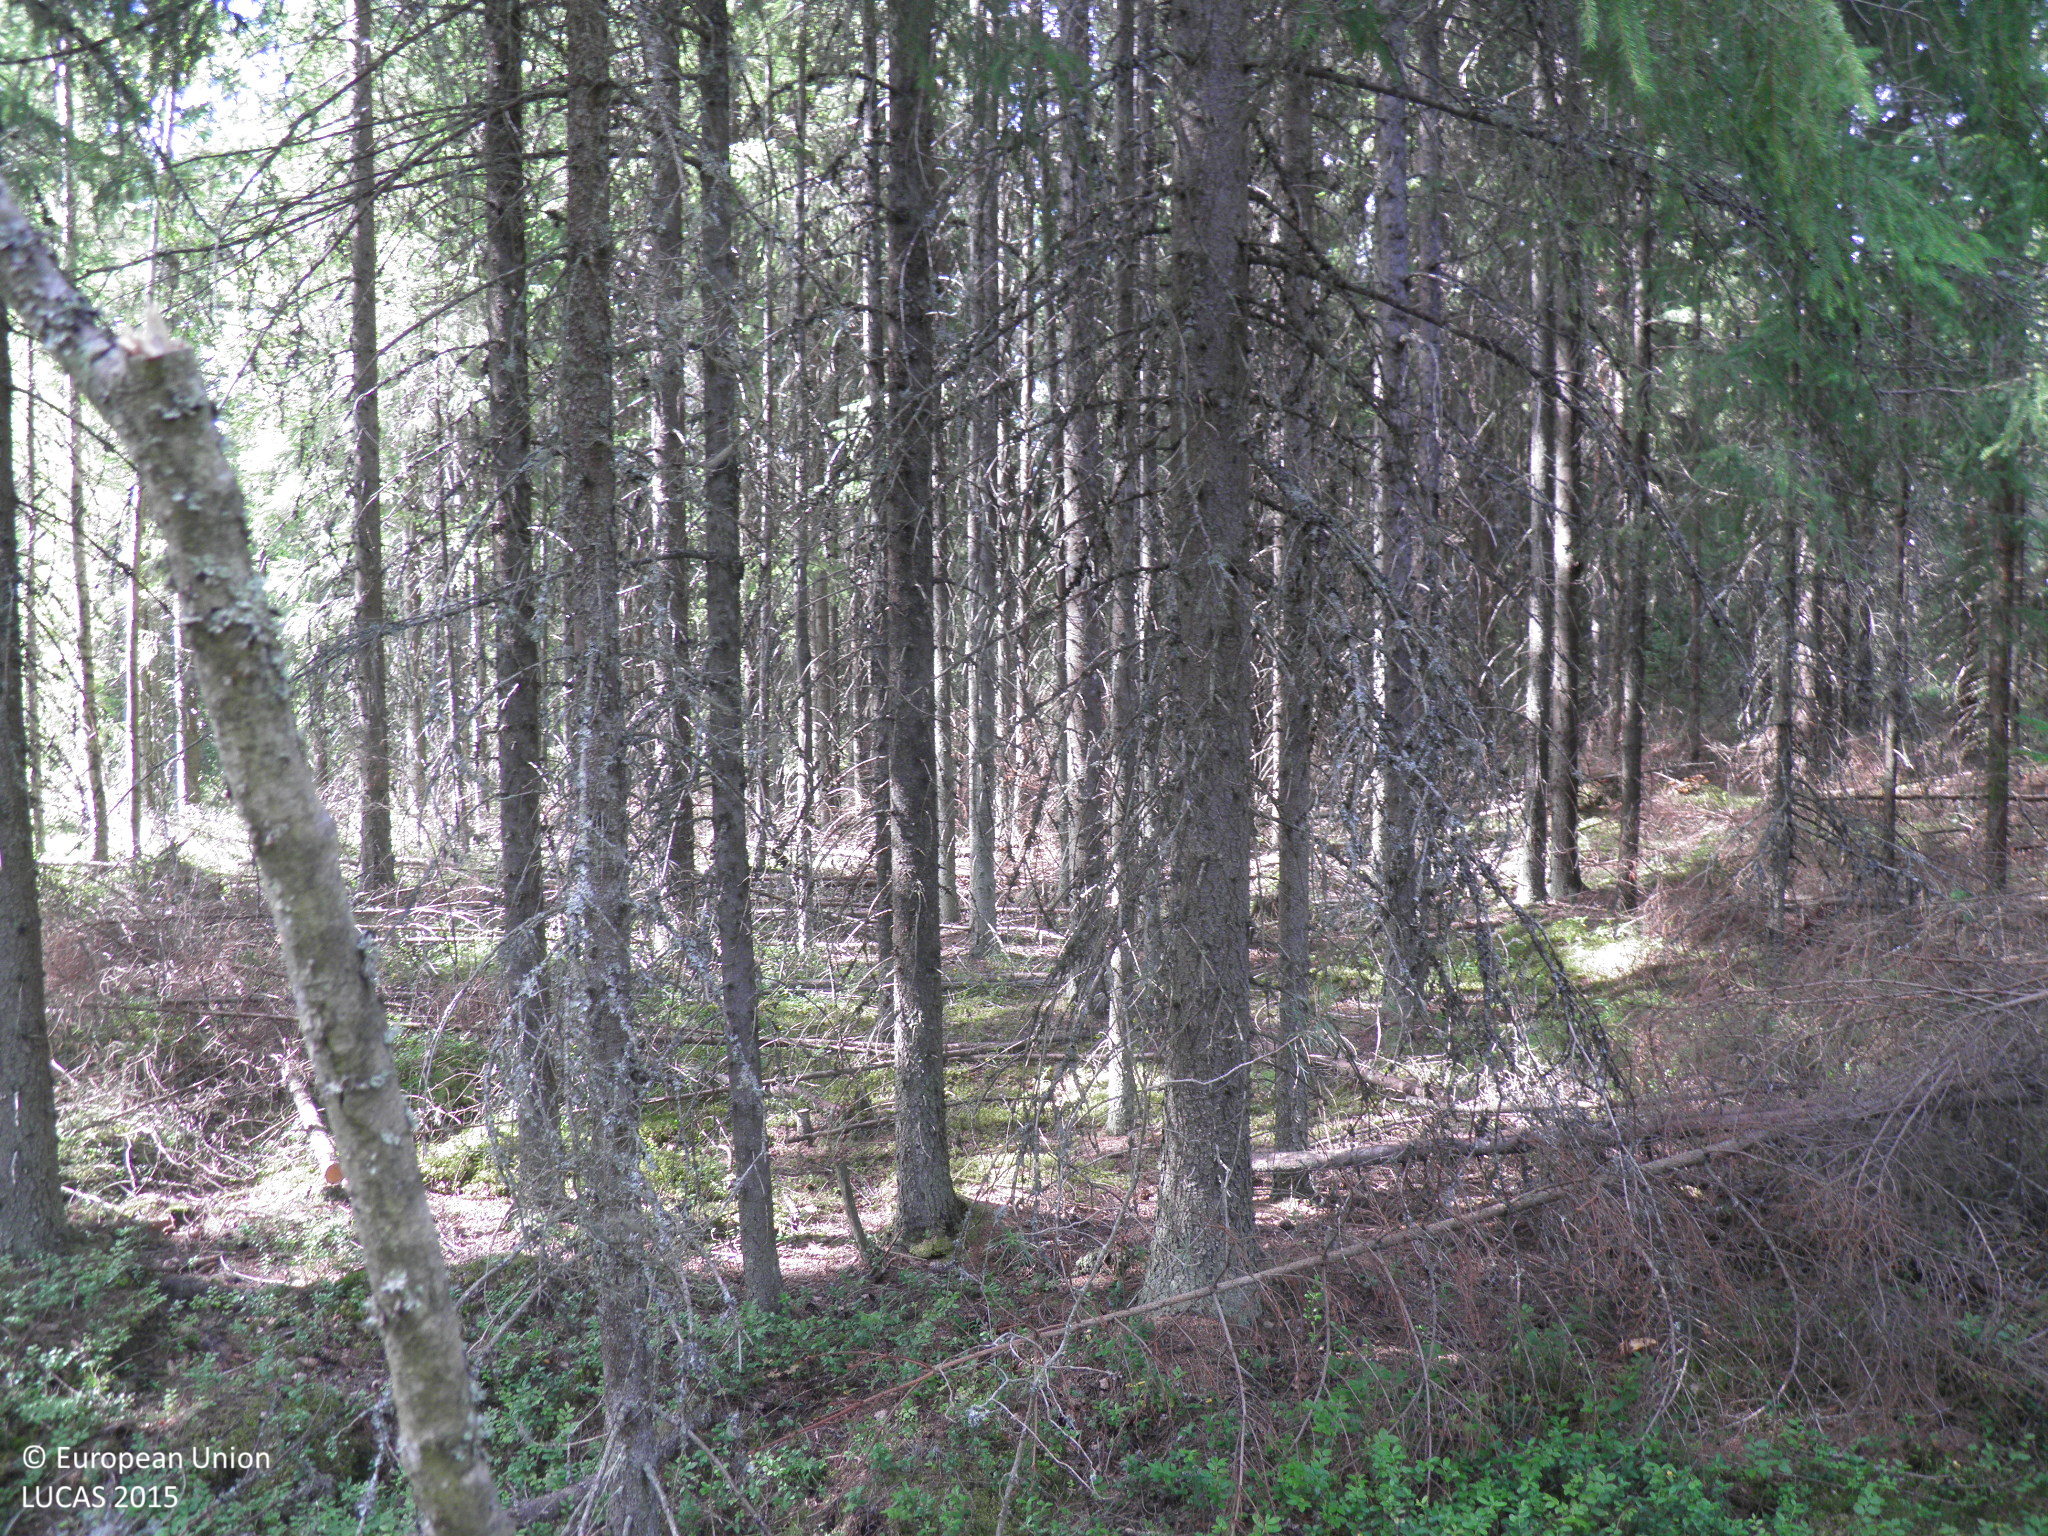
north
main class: Woodland
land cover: Spruce dominated coniferous woodland
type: hemiboreal forest and nemoral coniferous forest and mixed broadleaved-coniferous forest
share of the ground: 50 - 75 %
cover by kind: coniferous forest trees 50 %, shrubs 20 %, lichens and mosses 20 %, broadleaved forest trees 10 %
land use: Forestry
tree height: > 5 m
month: August
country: FI
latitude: 61.1326
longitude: 22.5634
